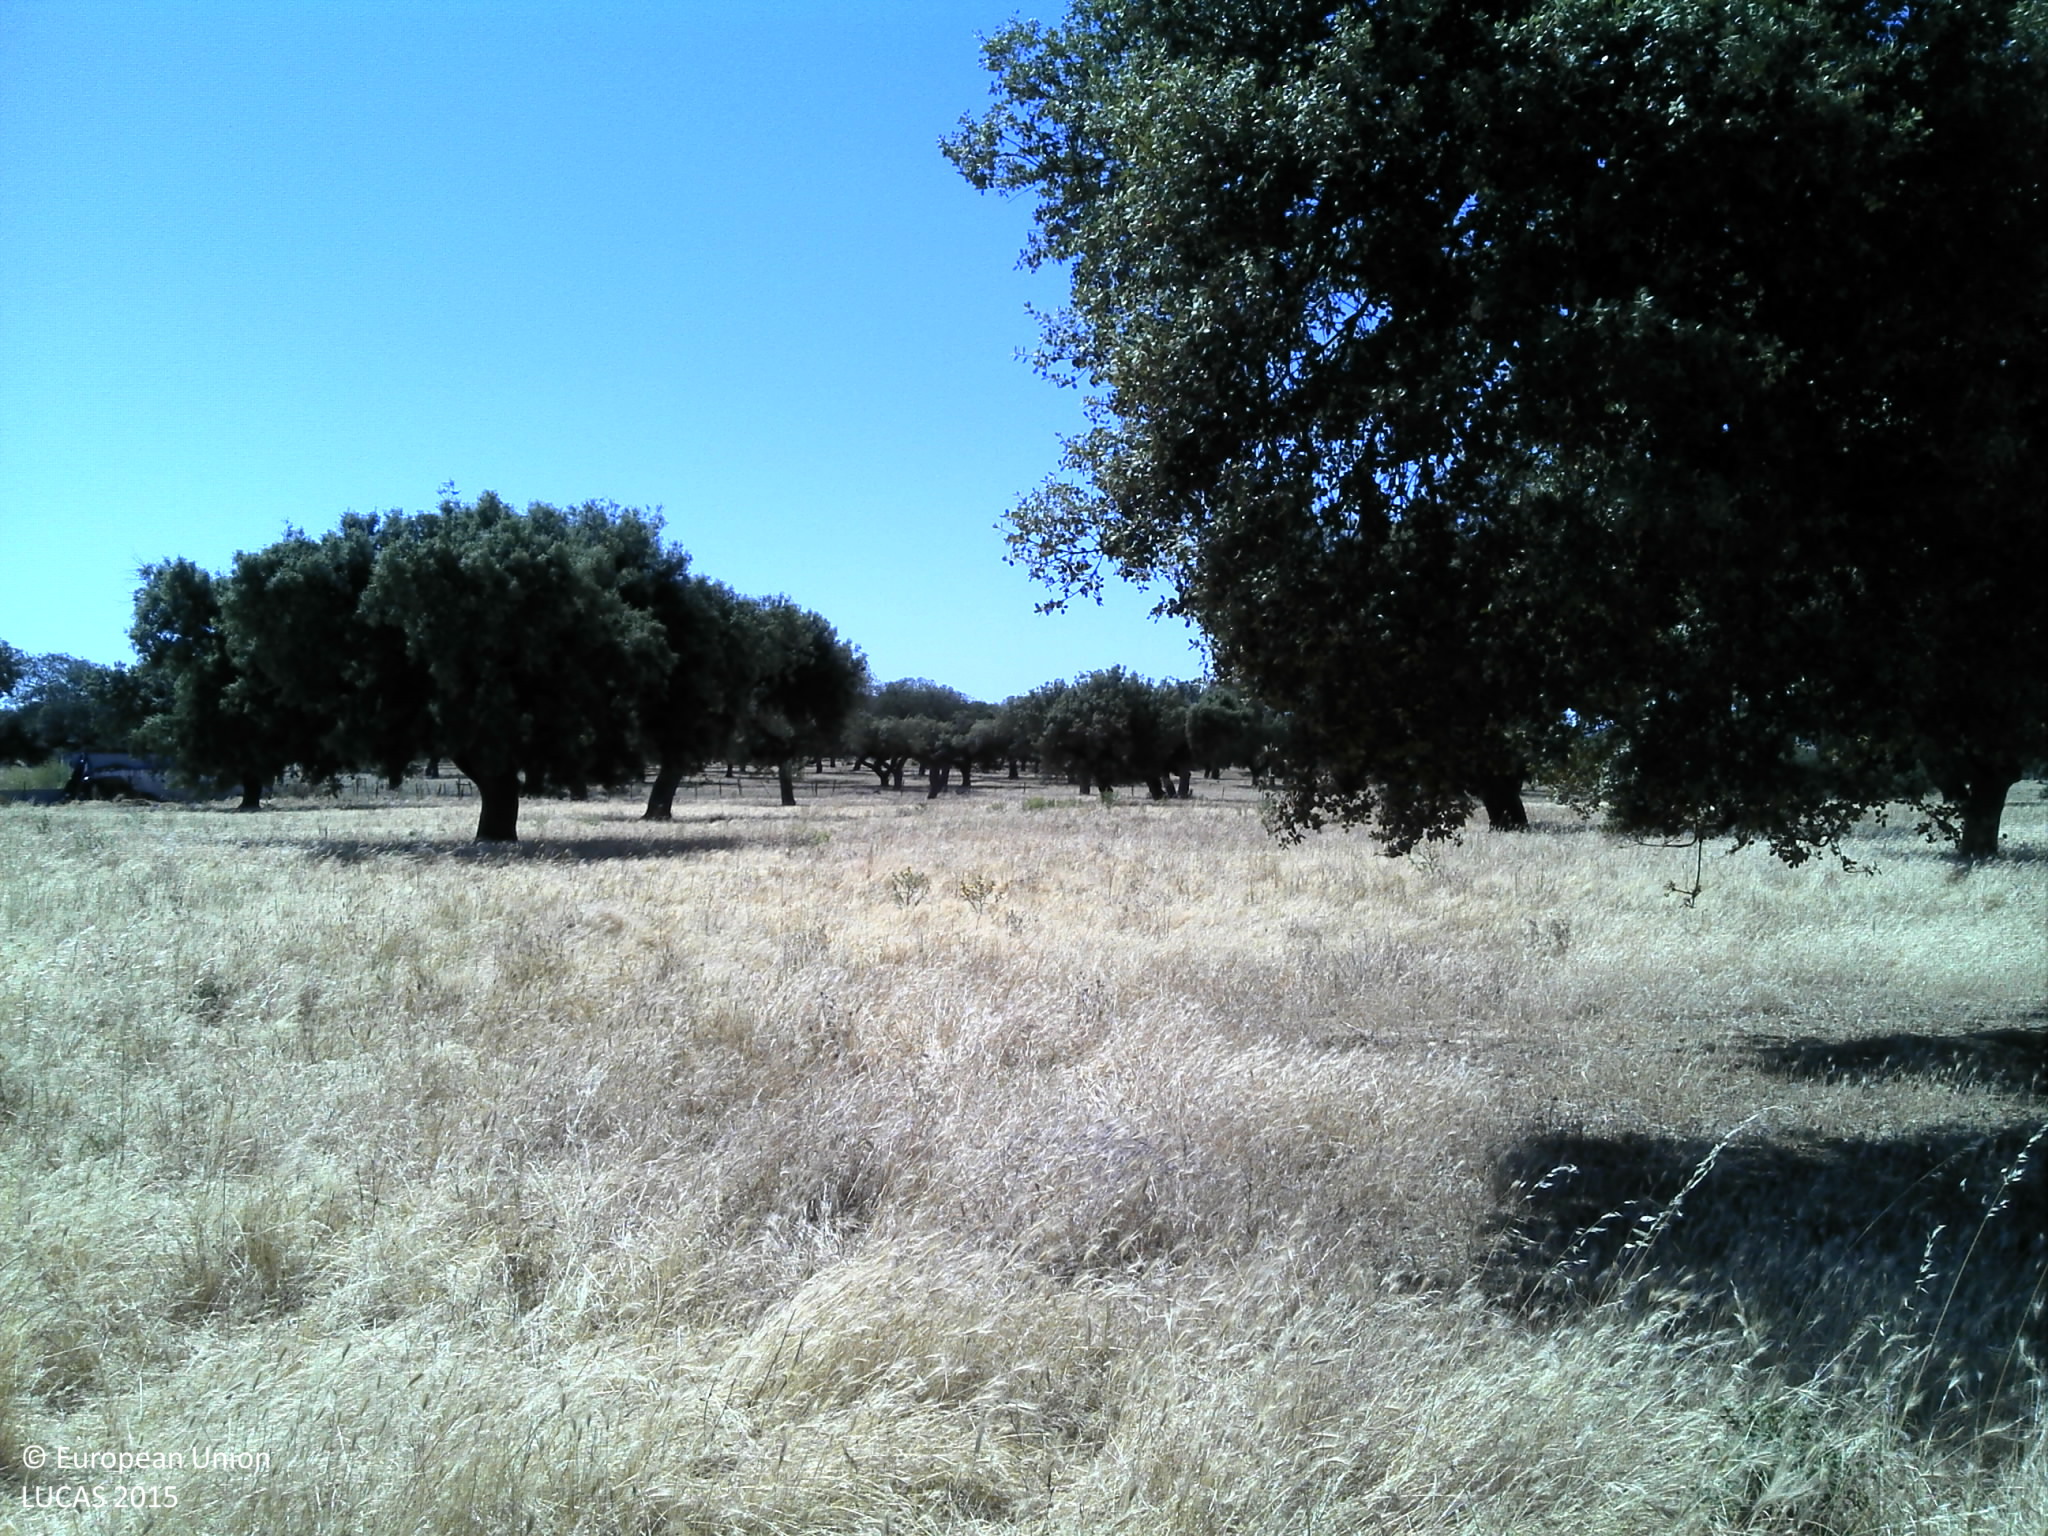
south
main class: Woodland
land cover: Broadleaved woodland
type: broadleaved evergreen forest
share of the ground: 10 - 25 %
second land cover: Grassland without tree/shrub cover
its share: 50 - 75 %
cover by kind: herbaceous plants 70 %, unconsolidated bare surface 20 %, broadleaved forest trees 10 %
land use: Forestry
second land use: Agriculture (excluding fallow land and kitchen gardens)
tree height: > 5 m
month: May
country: PT
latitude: 39.0077
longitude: -7.6285
